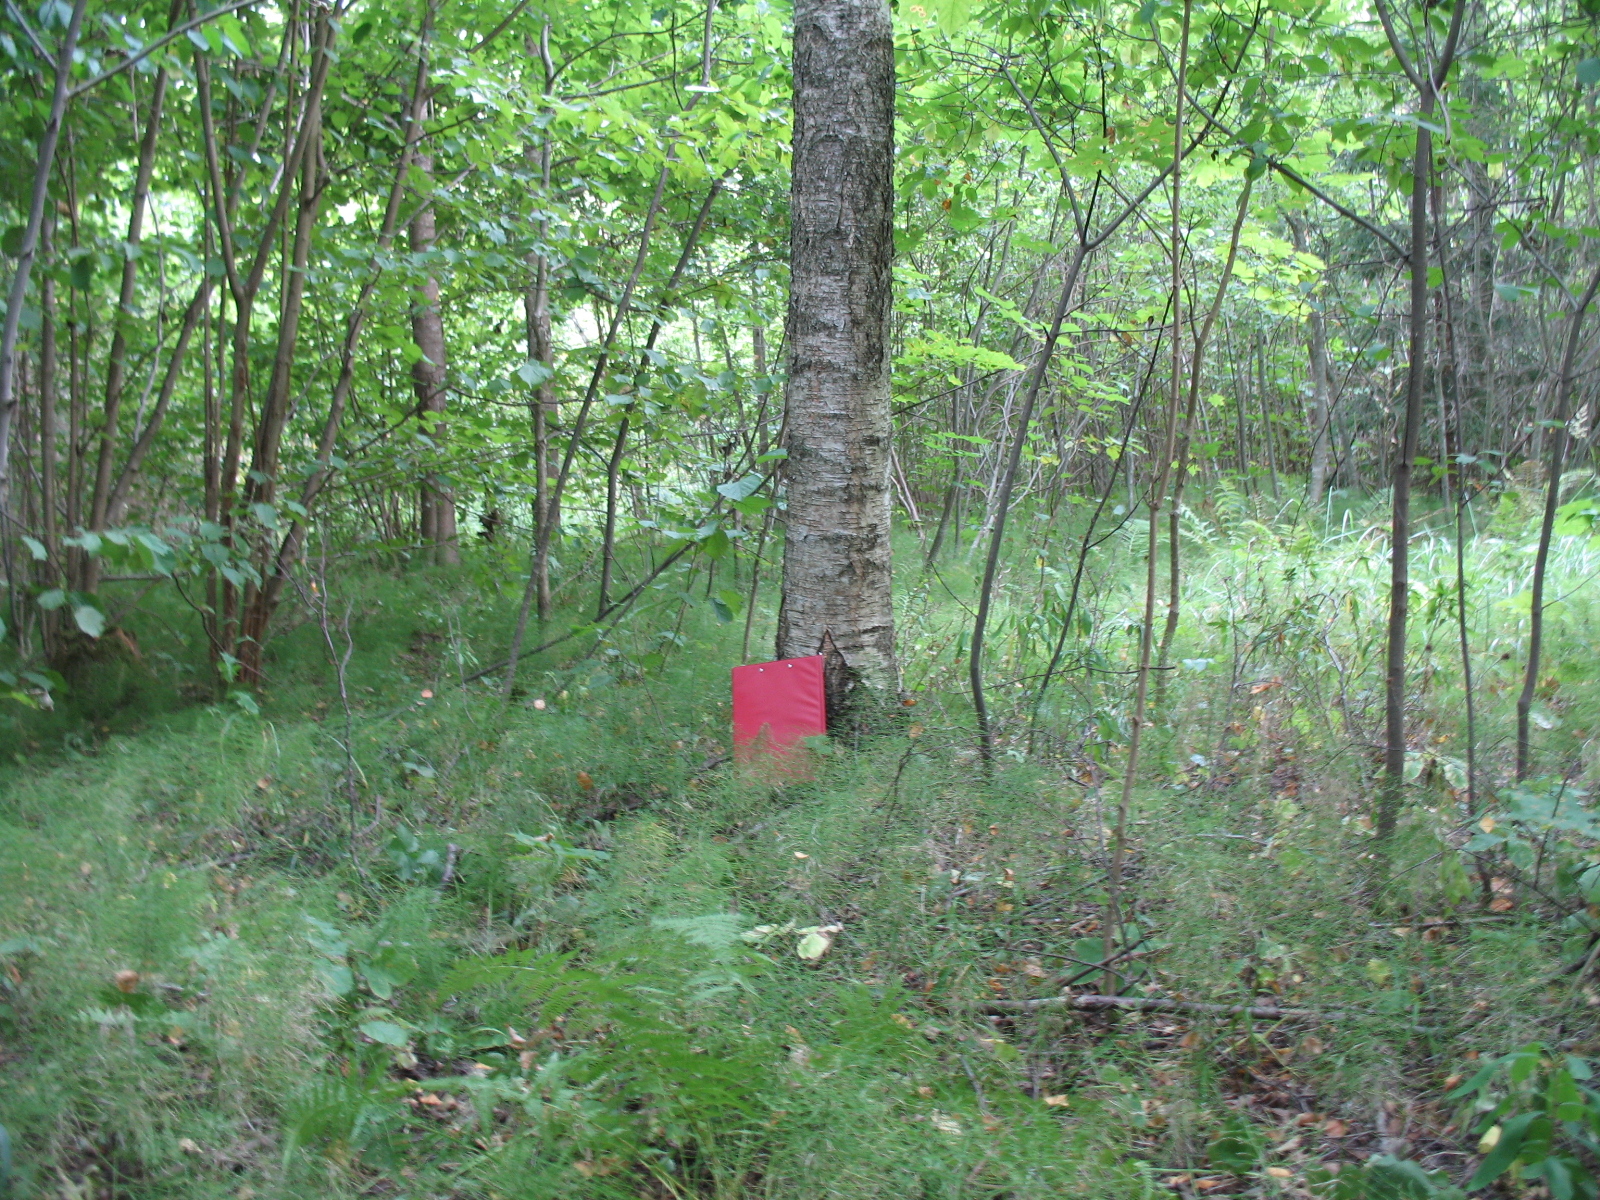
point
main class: Woodland
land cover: Broadleaved woodland
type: non-riverine alder, birch or aspen forest
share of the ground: > 75 %
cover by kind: broadleaved forest trees 80 %, herbaceous plants 15 %, coniferous forest trees 5 %
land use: Forestry
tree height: > 5 m
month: August
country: LV
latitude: 56.2641
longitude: 25.8063
